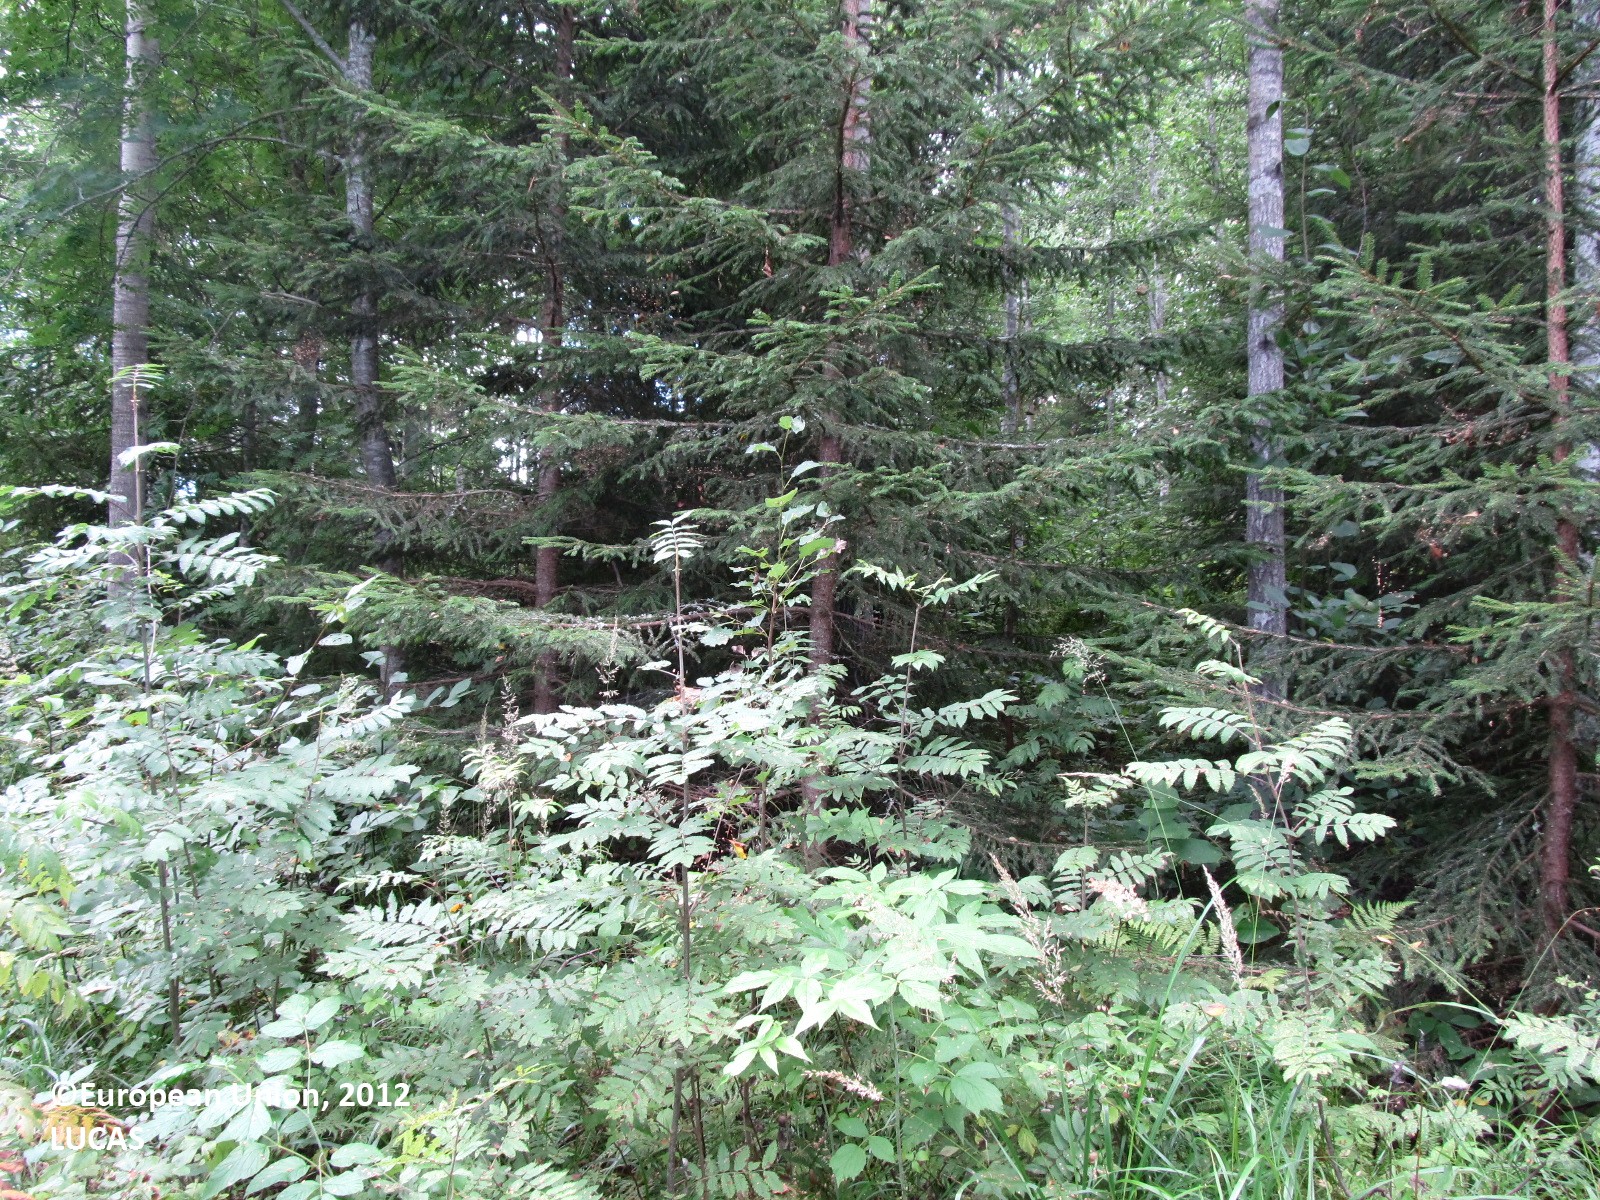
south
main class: Woodland
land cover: Spruce dominated mixed woodland
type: boreal forest
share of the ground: 50 - 75 %
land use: Forestry
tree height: > 5 m
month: August
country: FI
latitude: 61.7922
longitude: 27.8422
